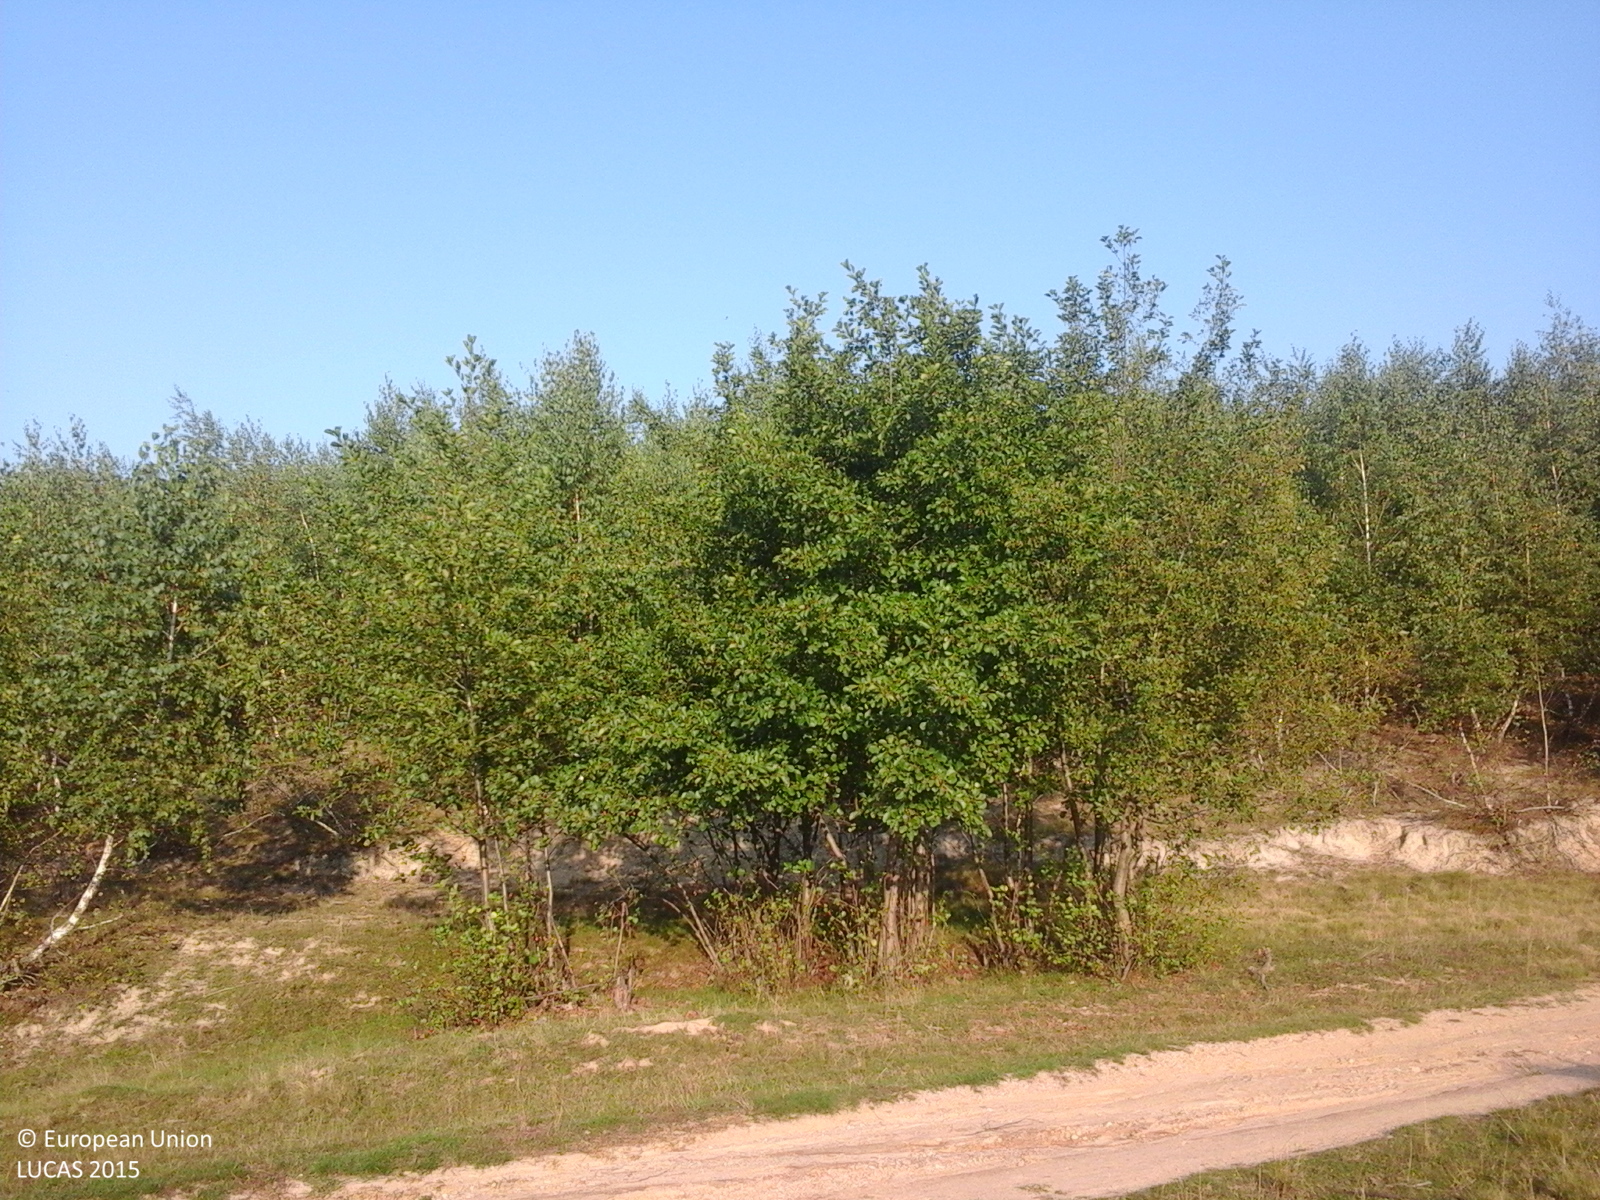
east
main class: Grassland
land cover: Grassland without tree/shrub cover
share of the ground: > 75 %
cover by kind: herbaceous plants 100 %
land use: Agriculture (excluding fallow land and kitchen gardens)
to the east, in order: Grassland without tree/shrub cover; Tracks; Broadleaved woodland; Spontaneously vegetated surfaces; Tracks; Grassland with sparse tree/shrub cover; Ditches and canals; Grassland with sparse tree/shrub cover
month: September
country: RO
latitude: 47.1098
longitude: 22.6422
